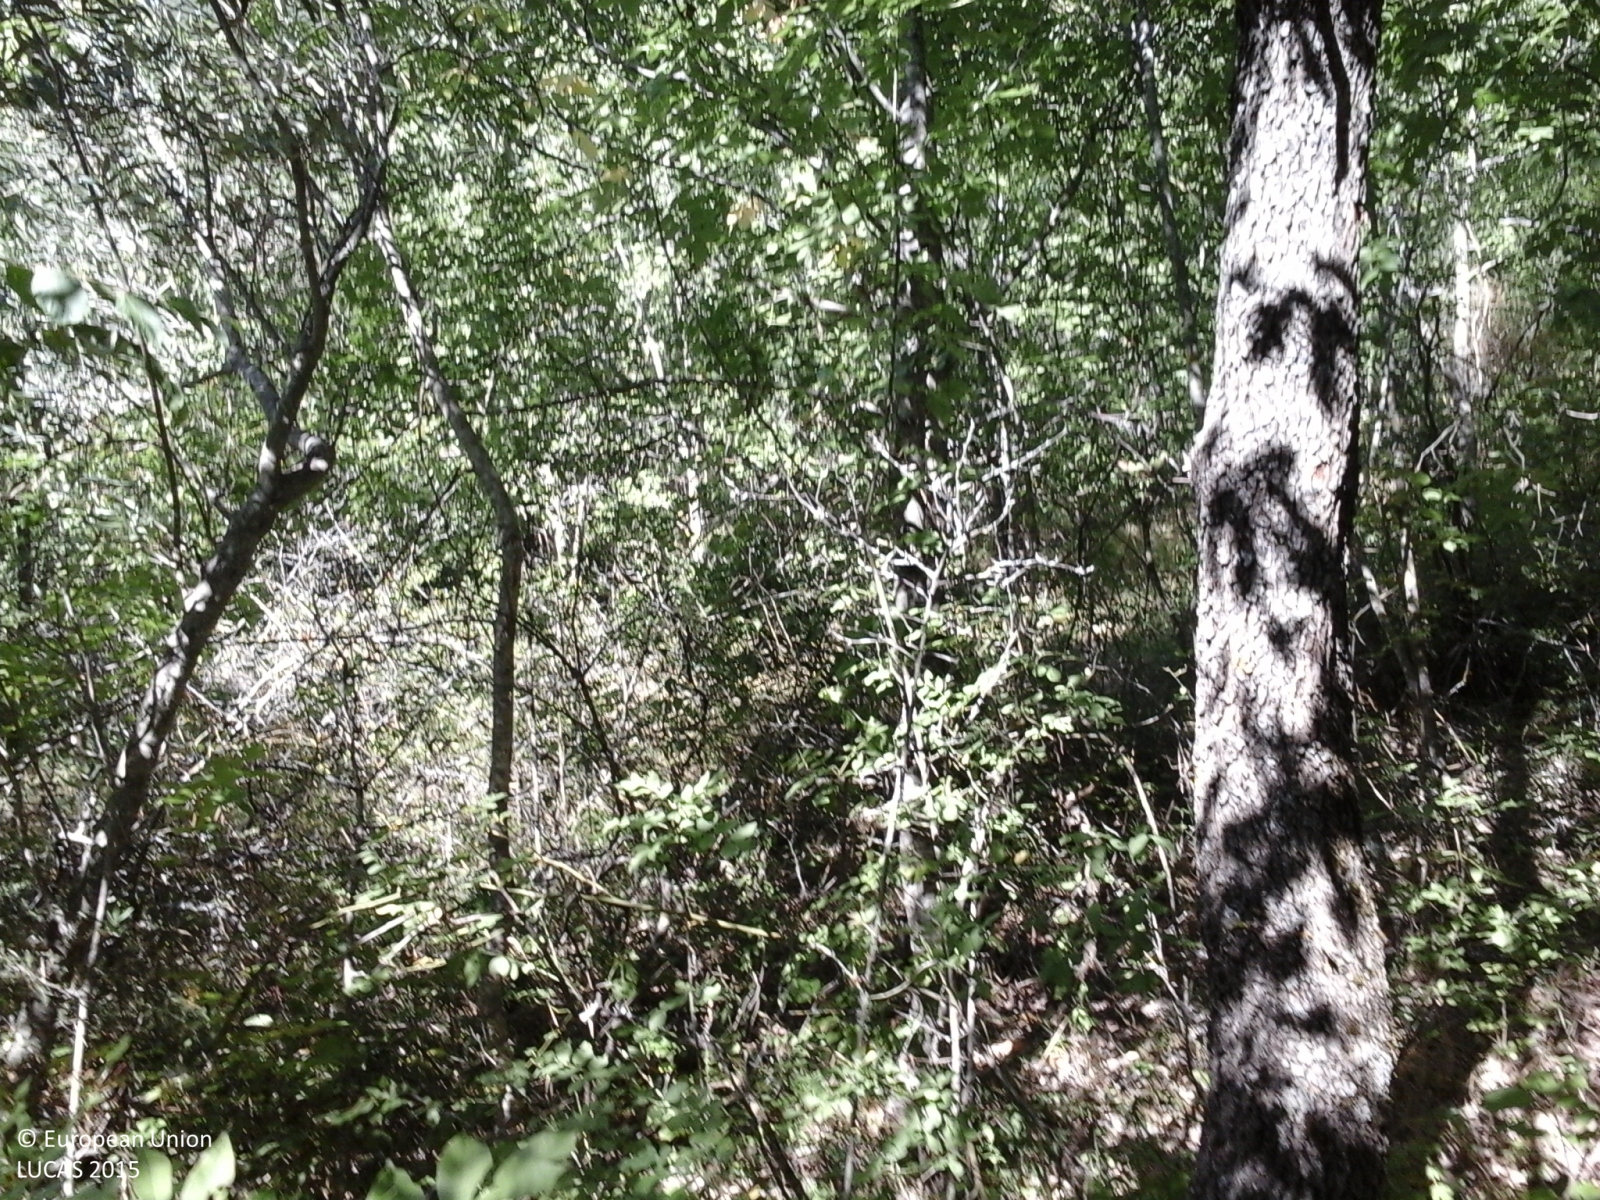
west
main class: Woodland
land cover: Broadleaved woodland
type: thermophilous deciduous forest
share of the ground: > 75 %
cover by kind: broadleaved forest trees 95 %, coniferous forest trees 5 %
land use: Forestry
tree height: > 5 m
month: August
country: IT
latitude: 43.1876
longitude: 13.0063
